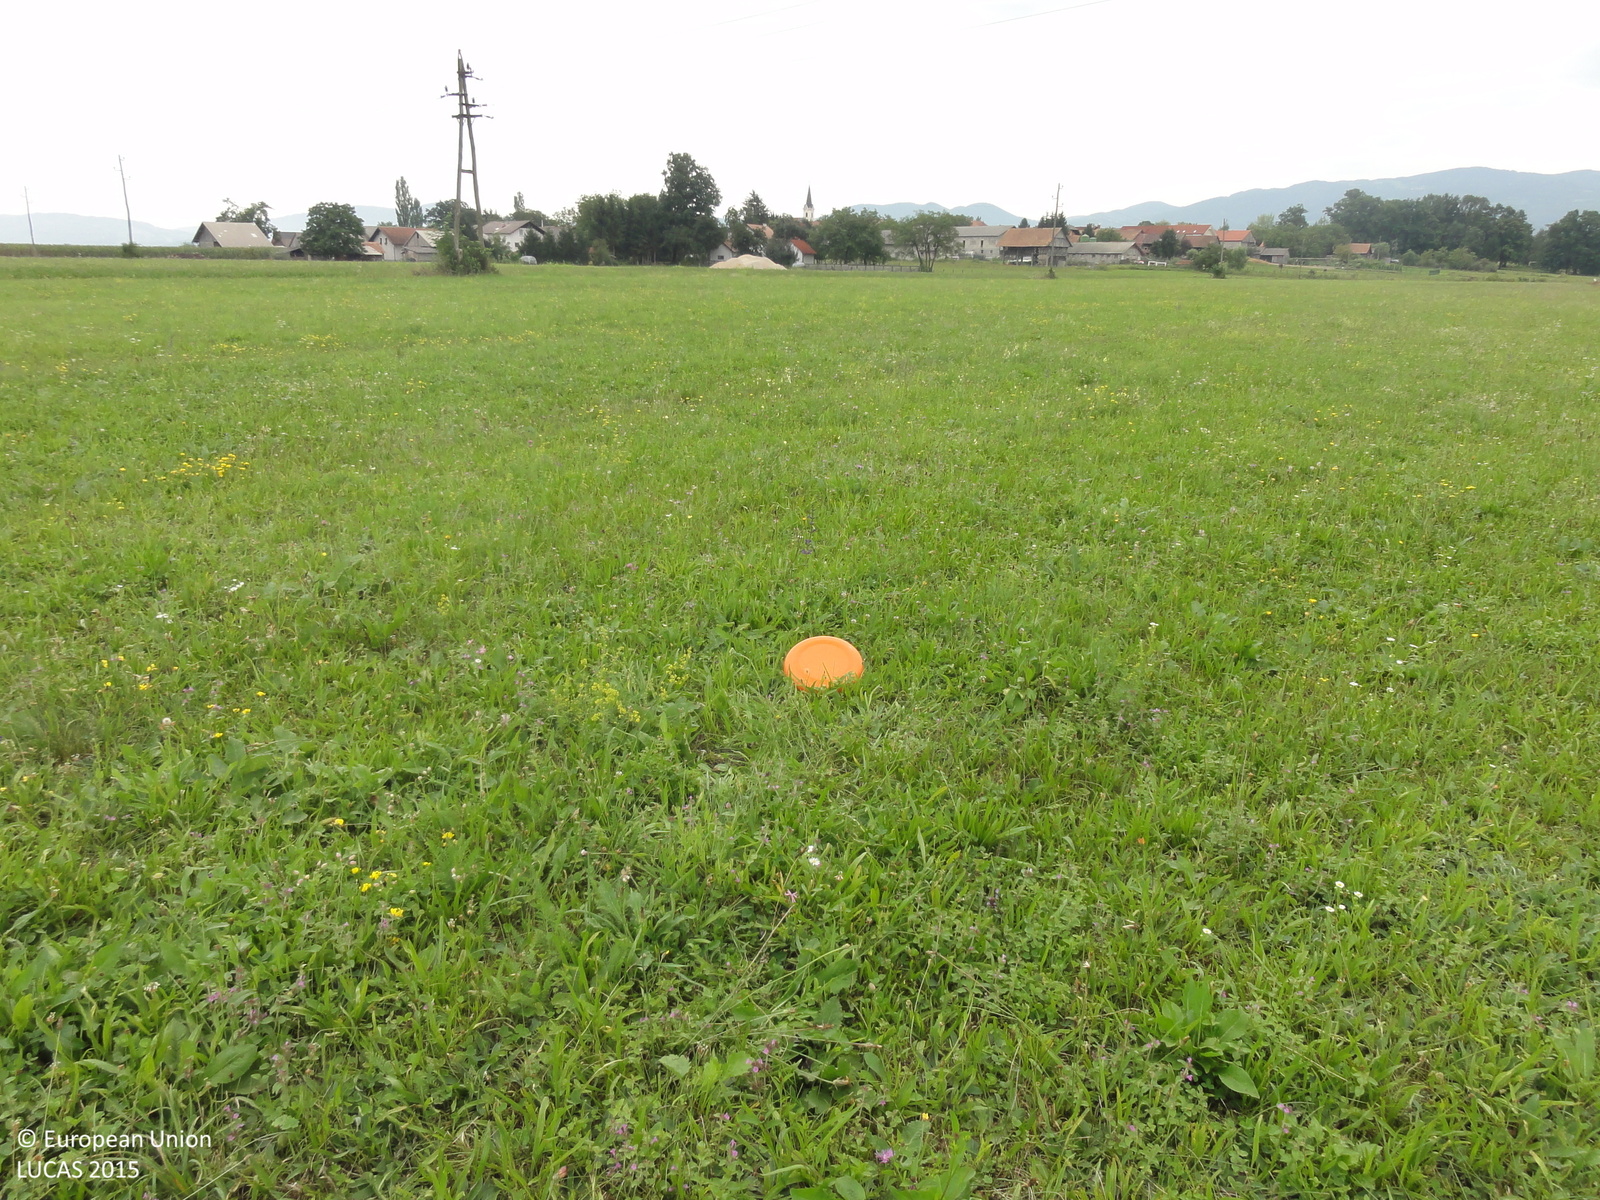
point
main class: Grassland
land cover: Grassland without tree/shrub cover
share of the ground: > 75 %
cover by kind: herbaceous plants 100 %
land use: Agriculture (excluding fallow land and kitchen gardens)
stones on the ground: < 10 %
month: August
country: SI
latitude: 45.9041
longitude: 15.4755
